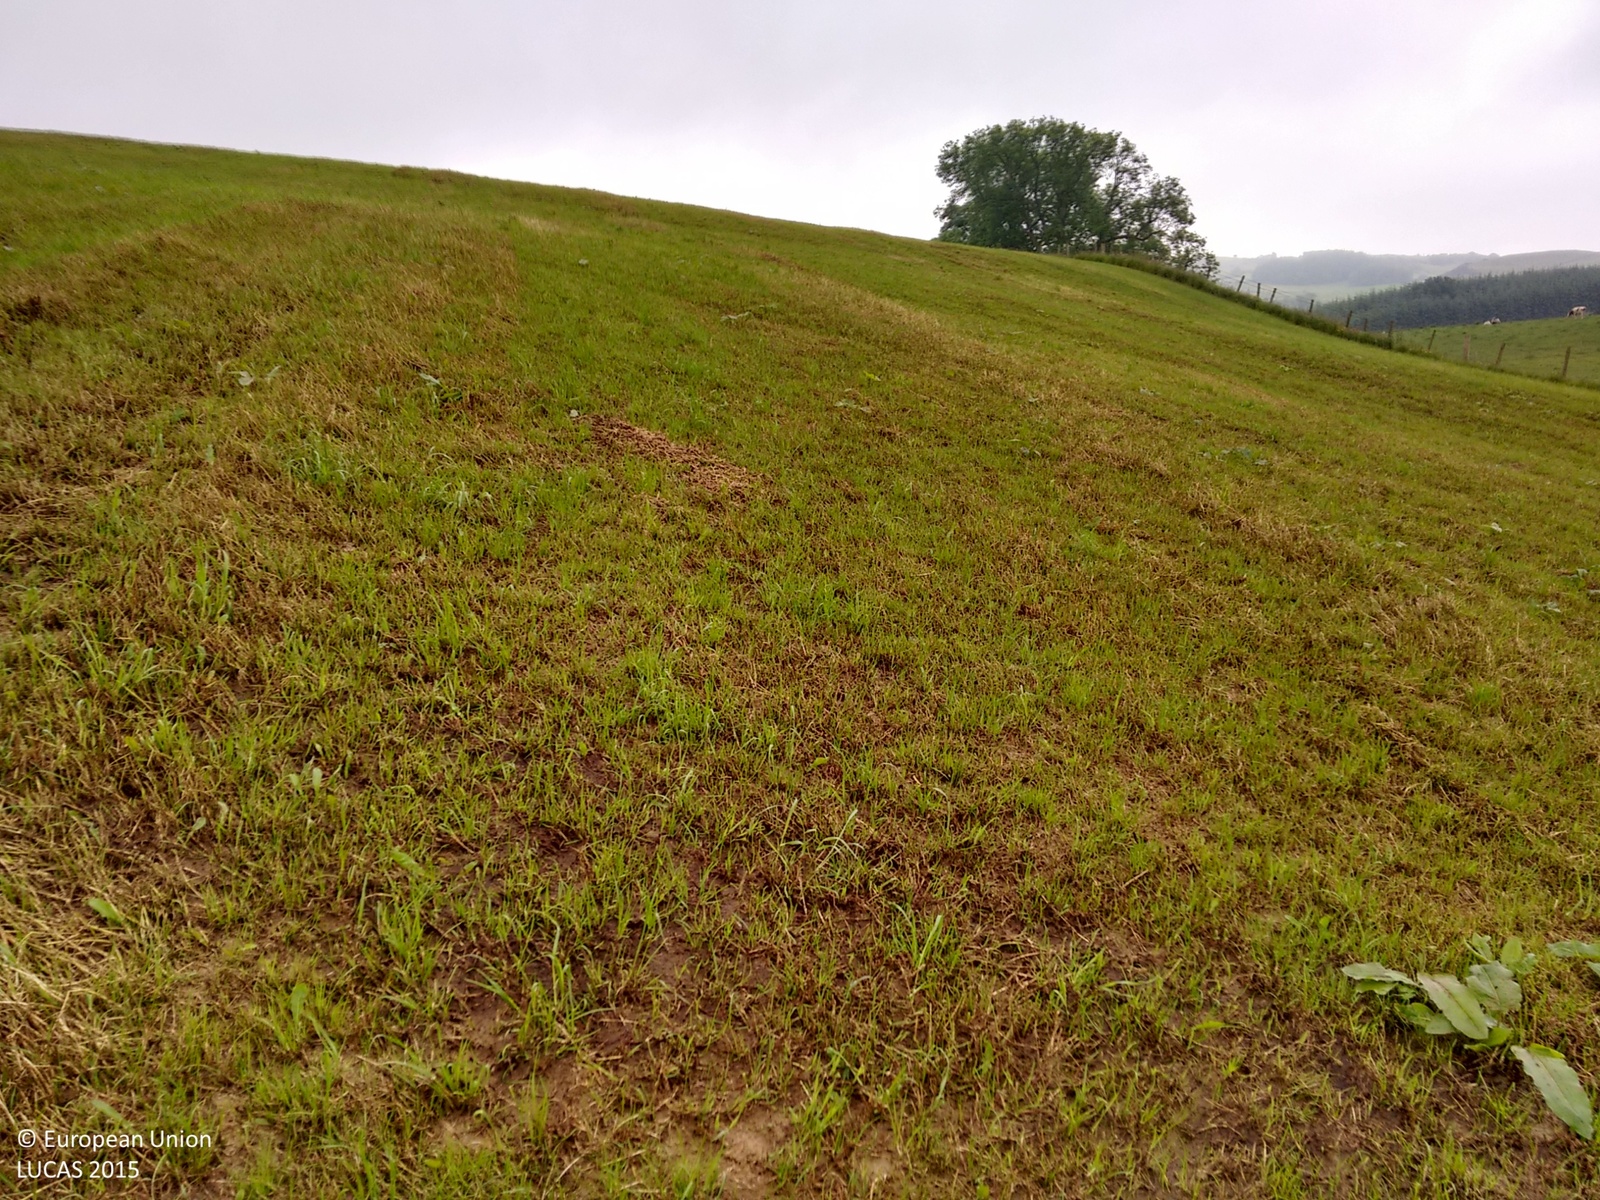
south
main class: Grassland
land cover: Grassland without tree/shrub cover
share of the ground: 25 - 50 %
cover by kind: herbaceous plants 50 %, unconsolidated bare surface 50 %
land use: Agriculture (excluding fallow land and kitchen gardens)
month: June
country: GB
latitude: 55.0656
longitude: -3.6915
